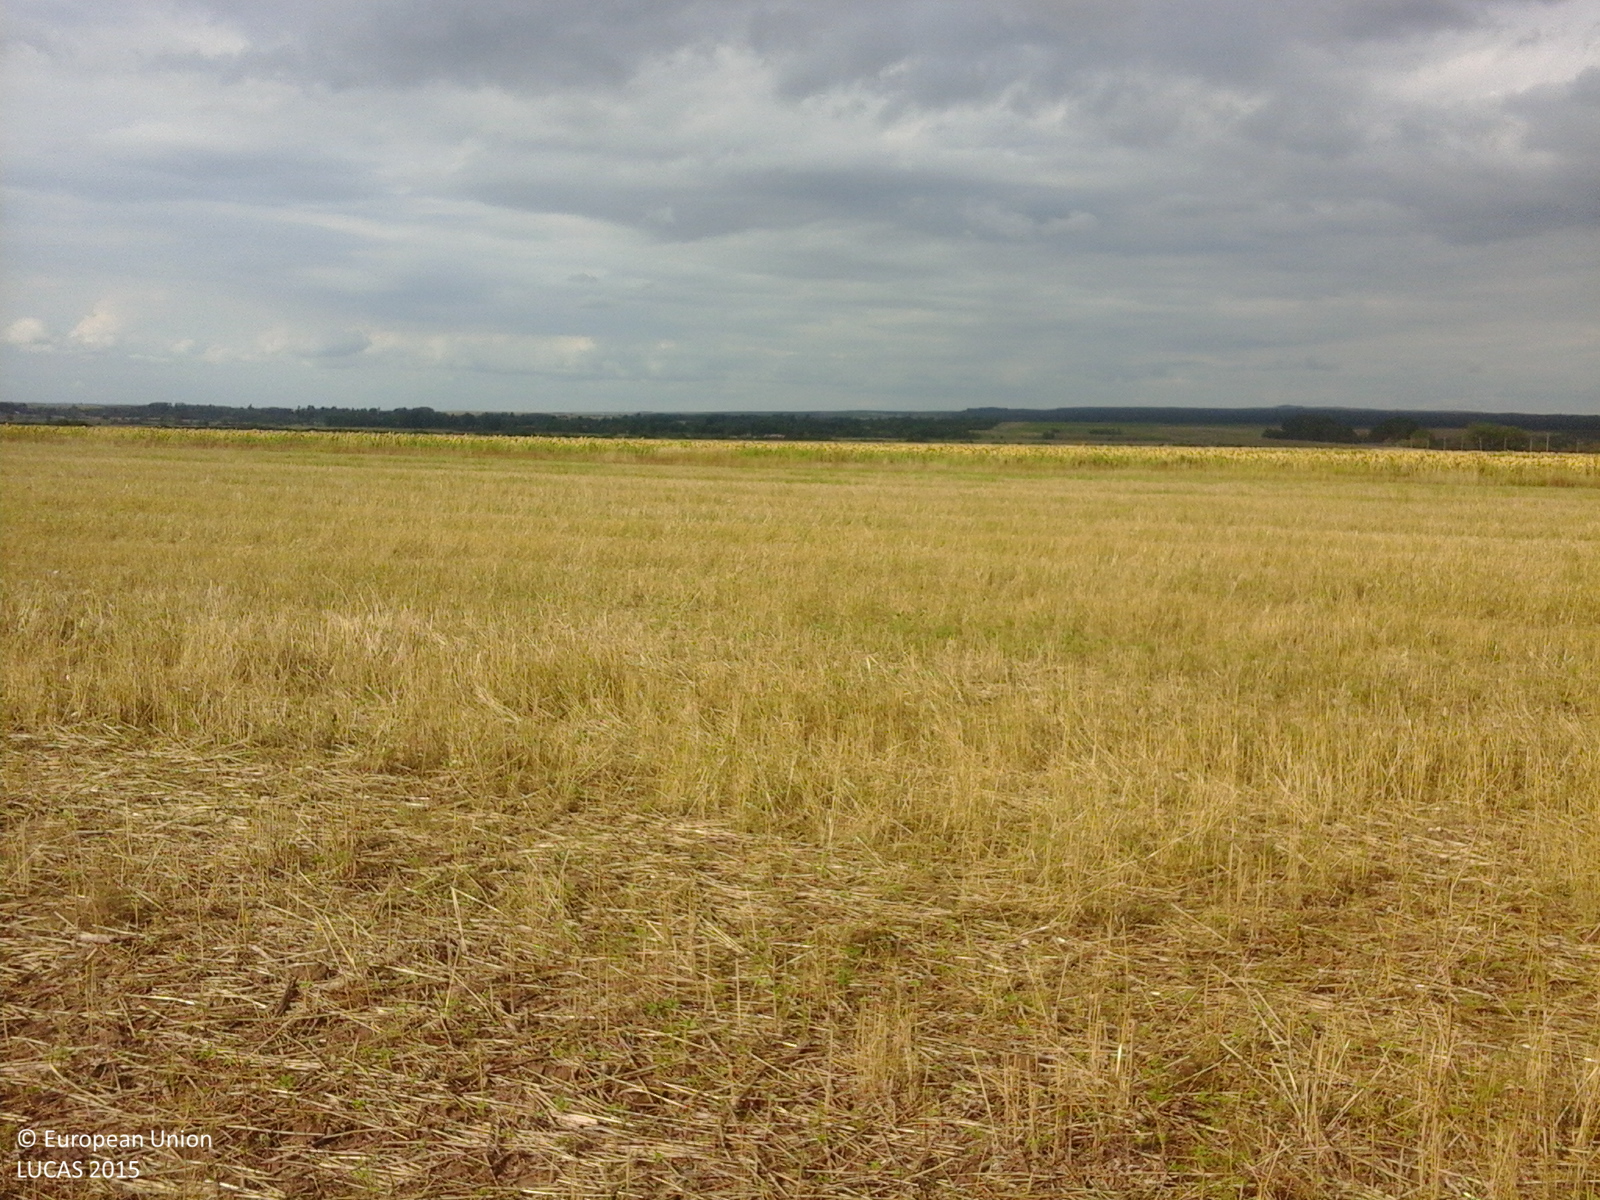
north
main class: Cropland
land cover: Common wheat
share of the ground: 25 - 50 %
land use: Agriculture (excluding fallow land and kitchen gardens)
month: August
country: RO
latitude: 45.5239
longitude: 21.5429
